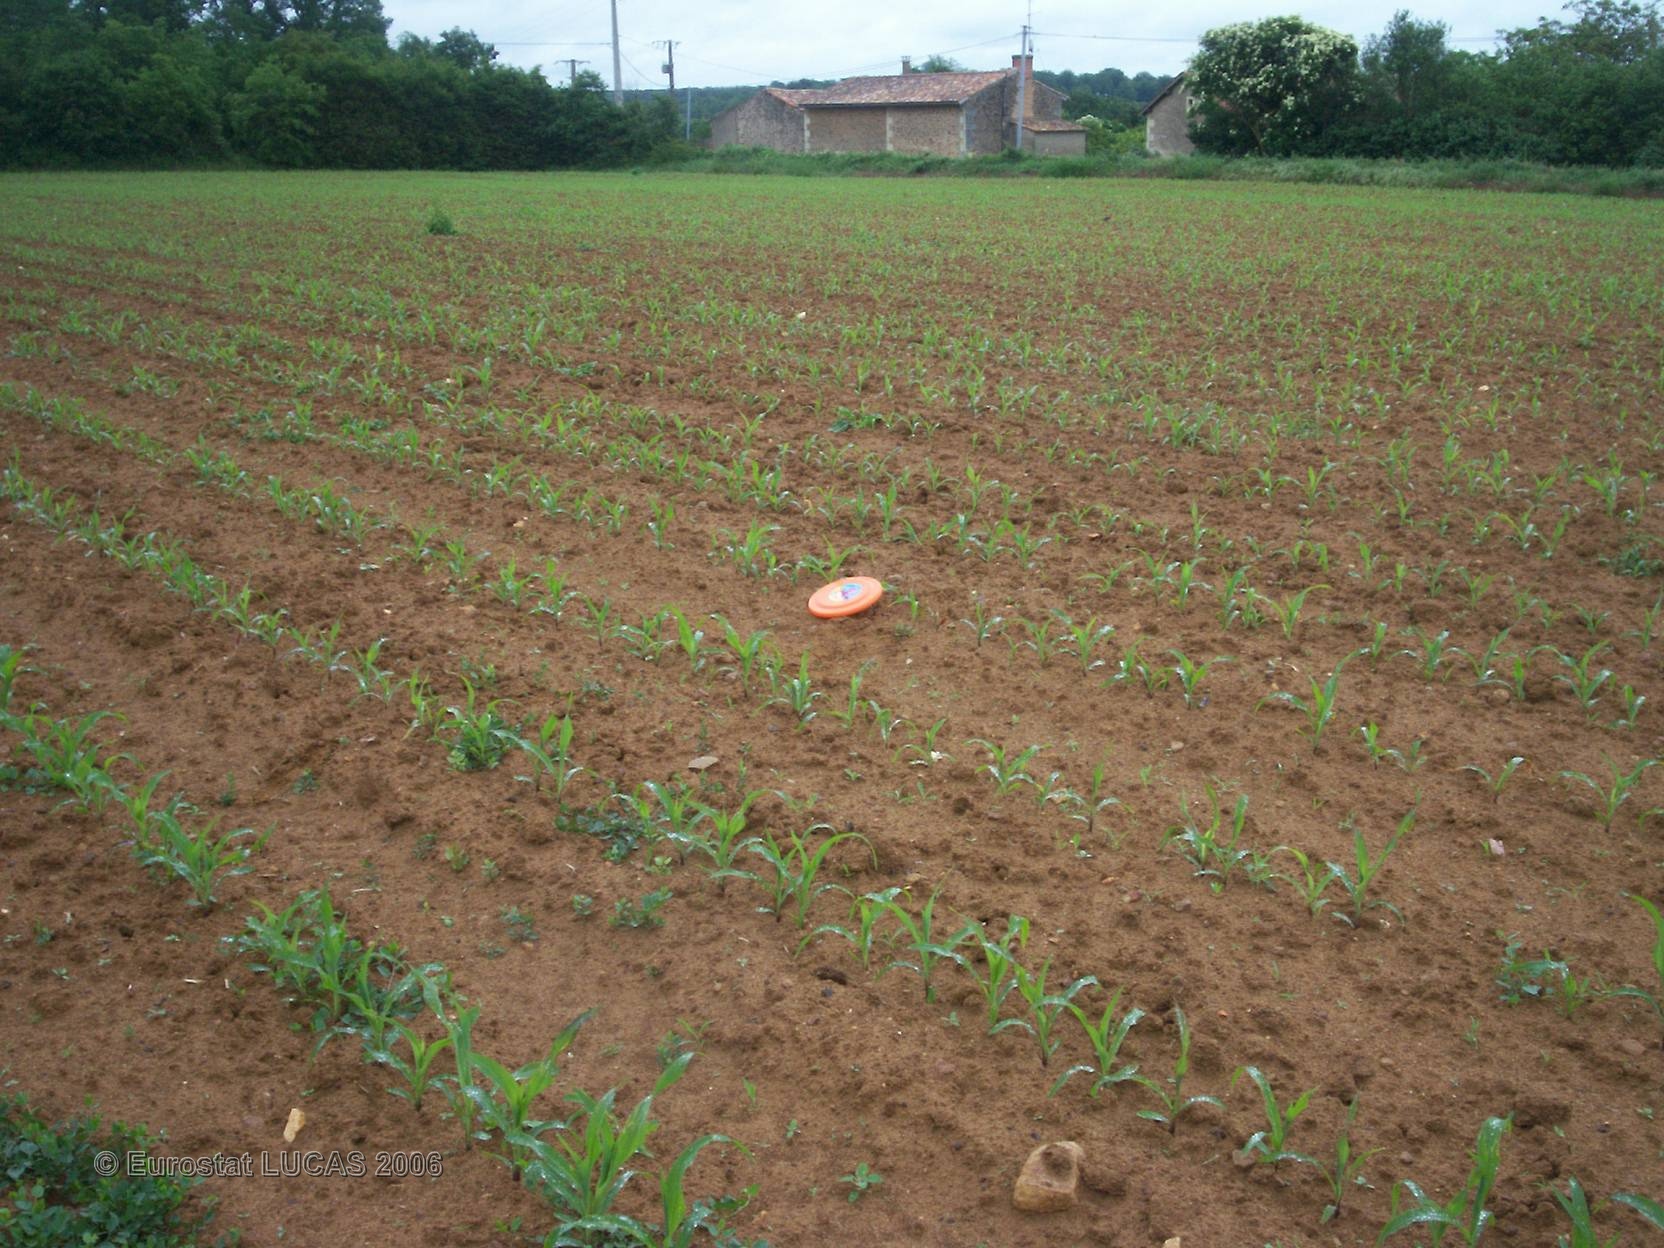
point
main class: Cropland
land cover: Maize
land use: Agriculture (excluding fallow land and kitchen gardens)
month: May
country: FR
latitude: 46.6845
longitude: 0.4501
